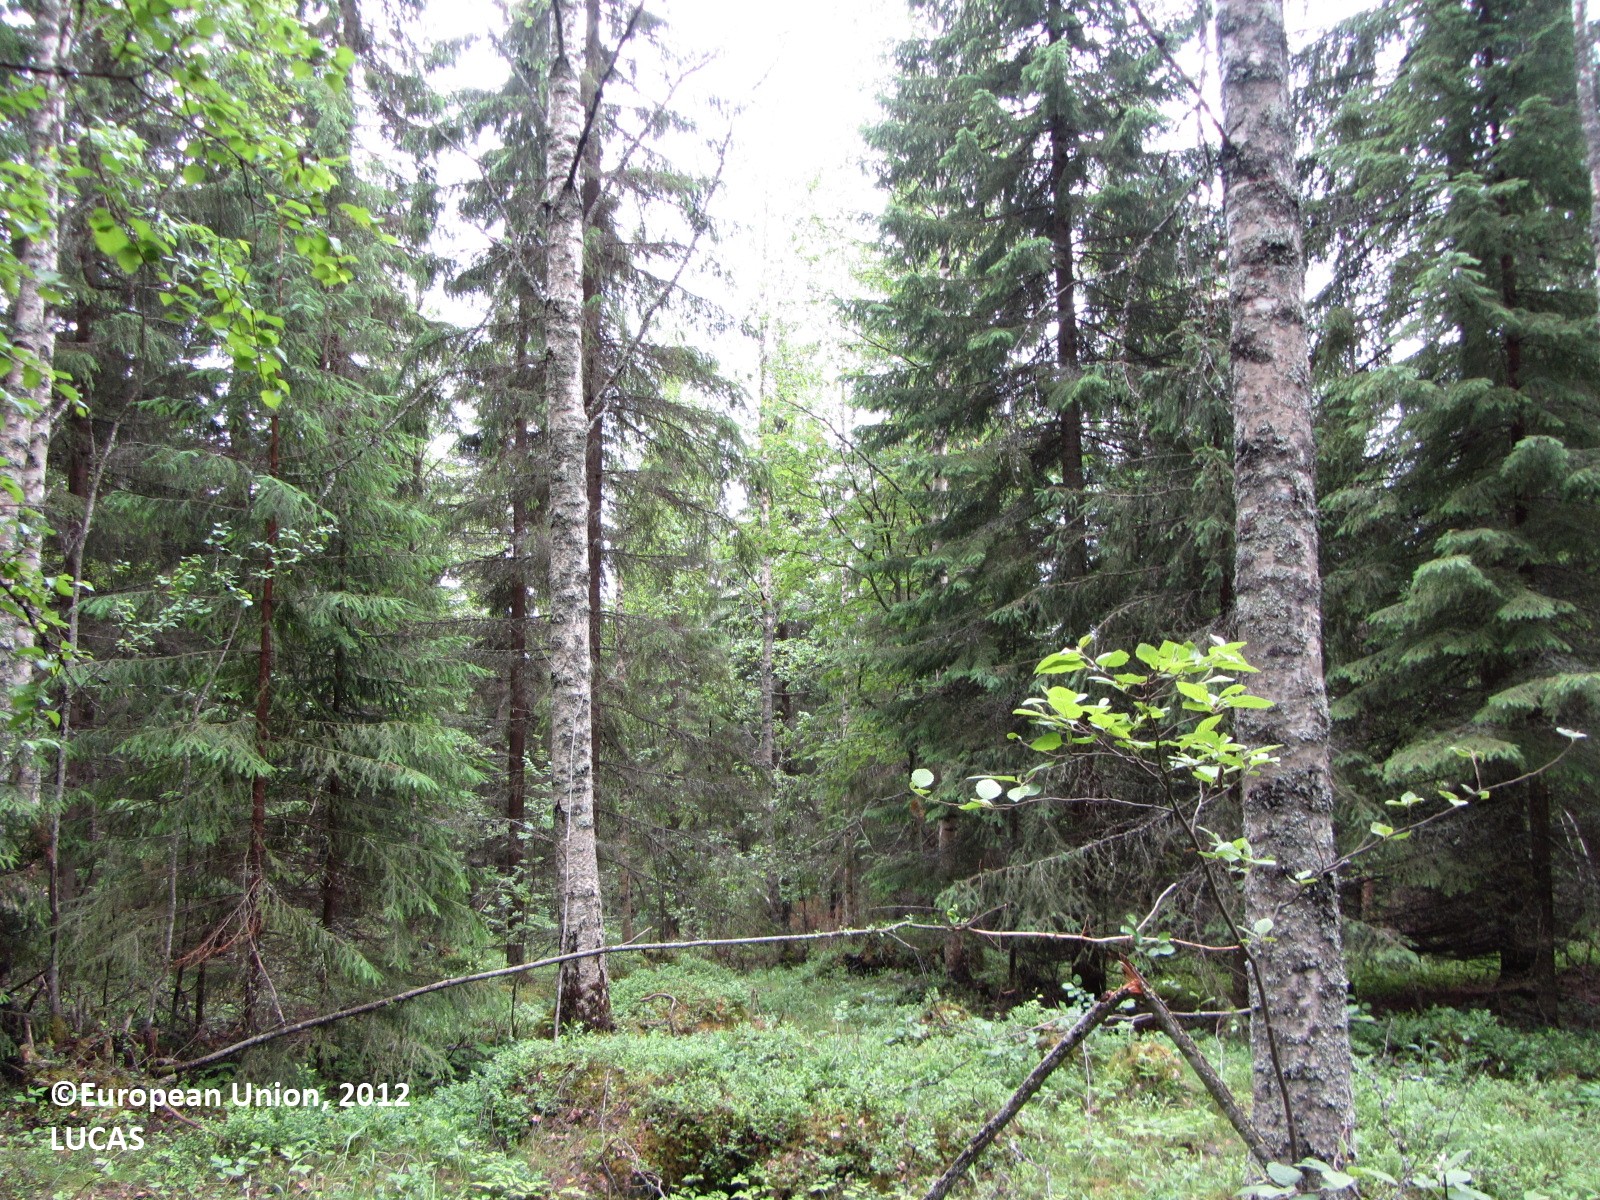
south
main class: Woodland
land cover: Spruce dominated mixed woodland
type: boreal forest
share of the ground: 50 - 75 %
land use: Forestry
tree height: > 5 m
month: July
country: FI
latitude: 62.9367
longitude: 25.0502
